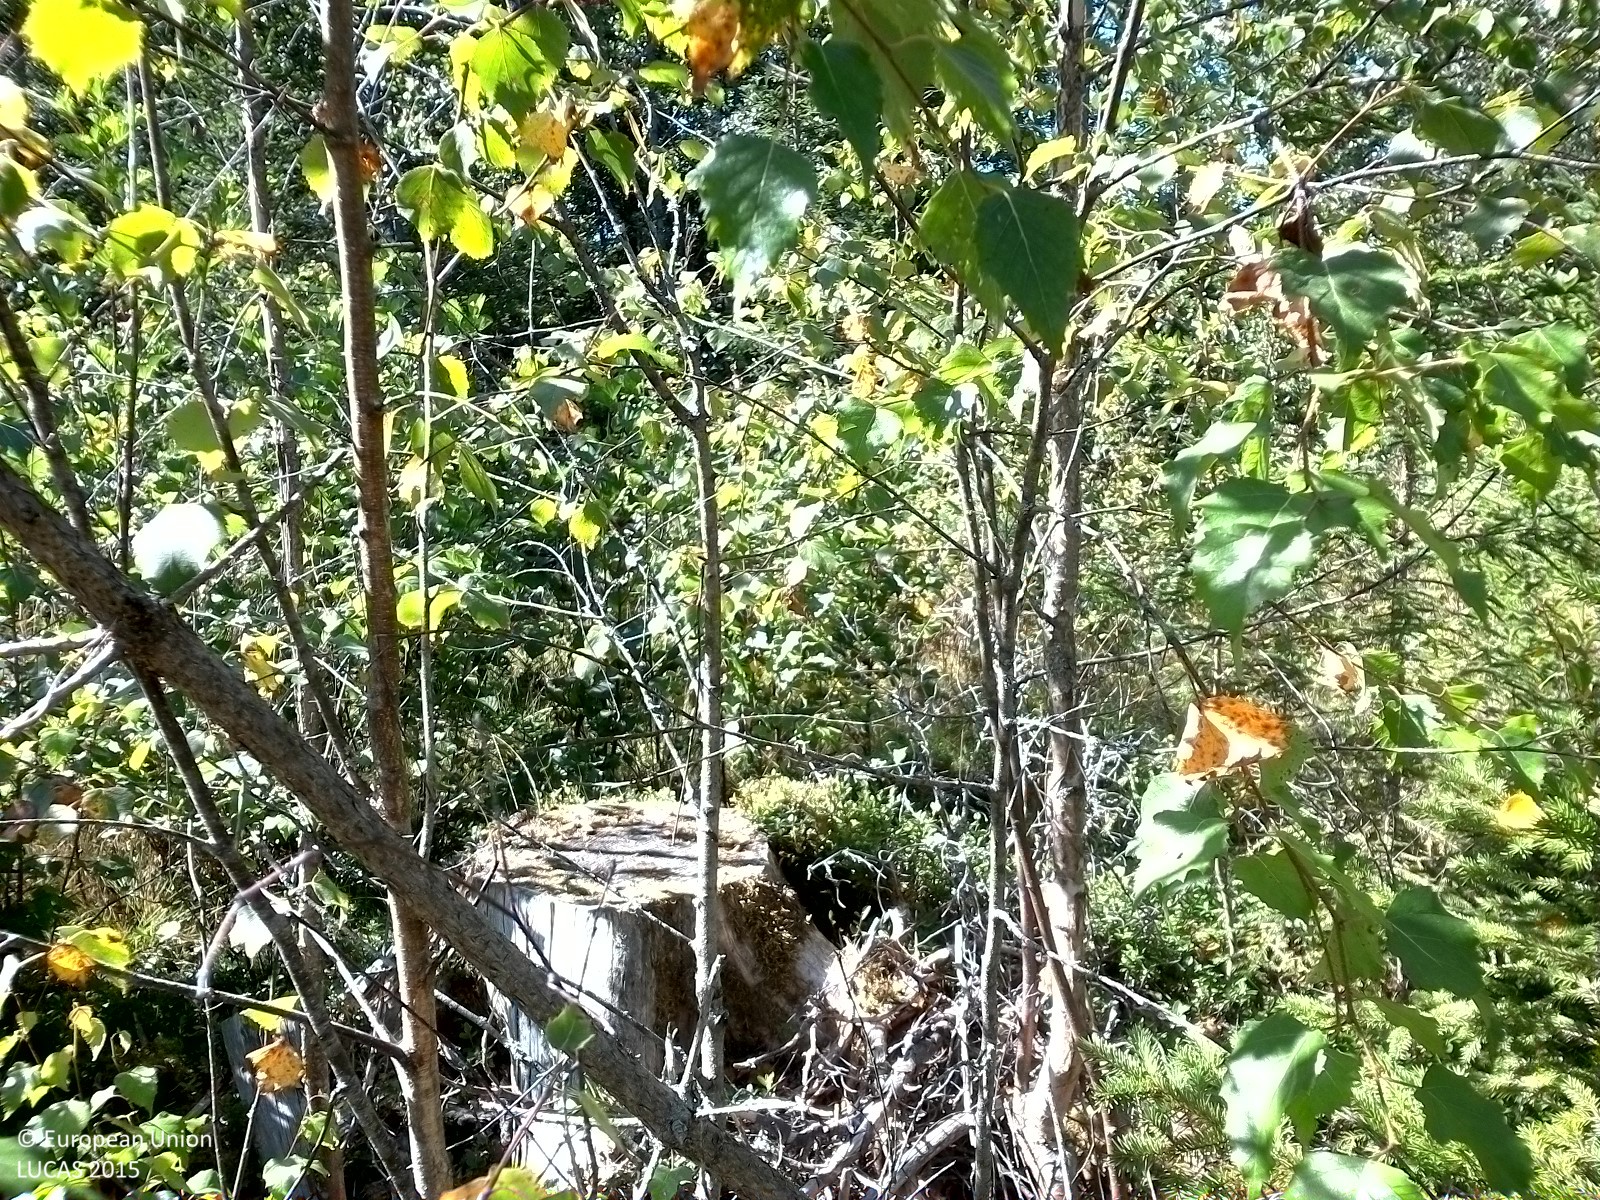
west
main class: Woodland
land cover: Spruce dominated mixed woodland
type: boreal forest
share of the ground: 50 - 75 %
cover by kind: coniferous forest trees 35 %, broadleaved forest trees 25 %, herbaceous plants 20 %, lichens and mosses 20 %
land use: Forestry
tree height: < 5 m
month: August
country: SE
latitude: 59.2111
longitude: 15.4040
